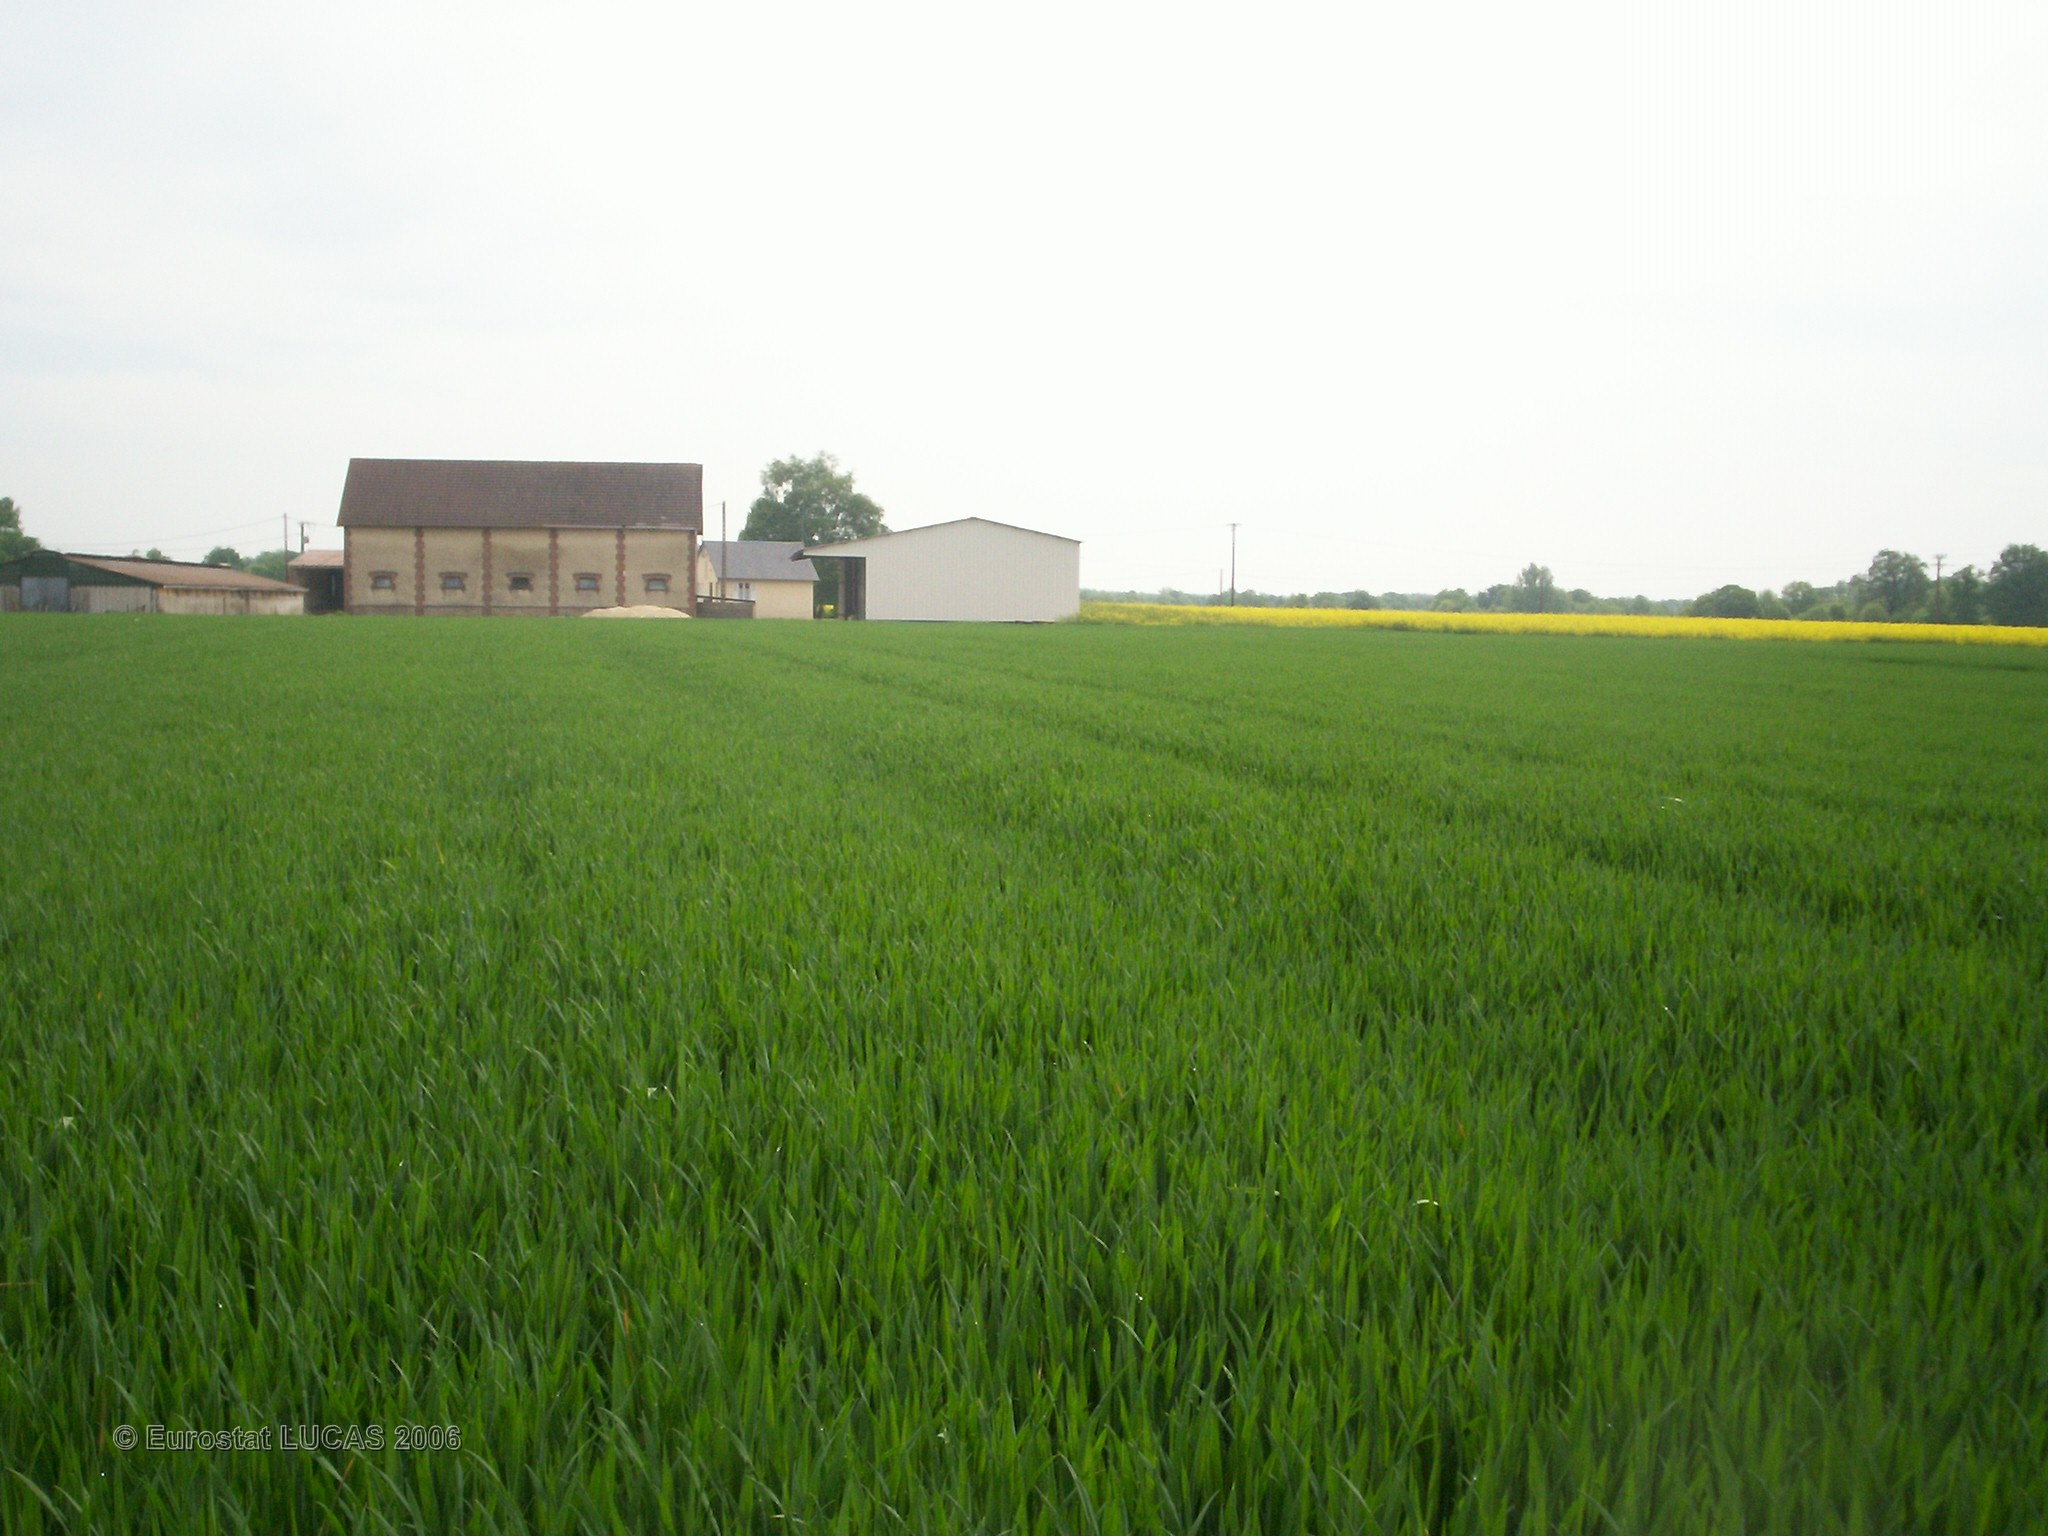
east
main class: Cropland
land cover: Barley
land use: Agriculture (excluding fallow land and kitchen gardens)
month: May
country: FR
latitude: 47.7475
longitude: 2.9912
